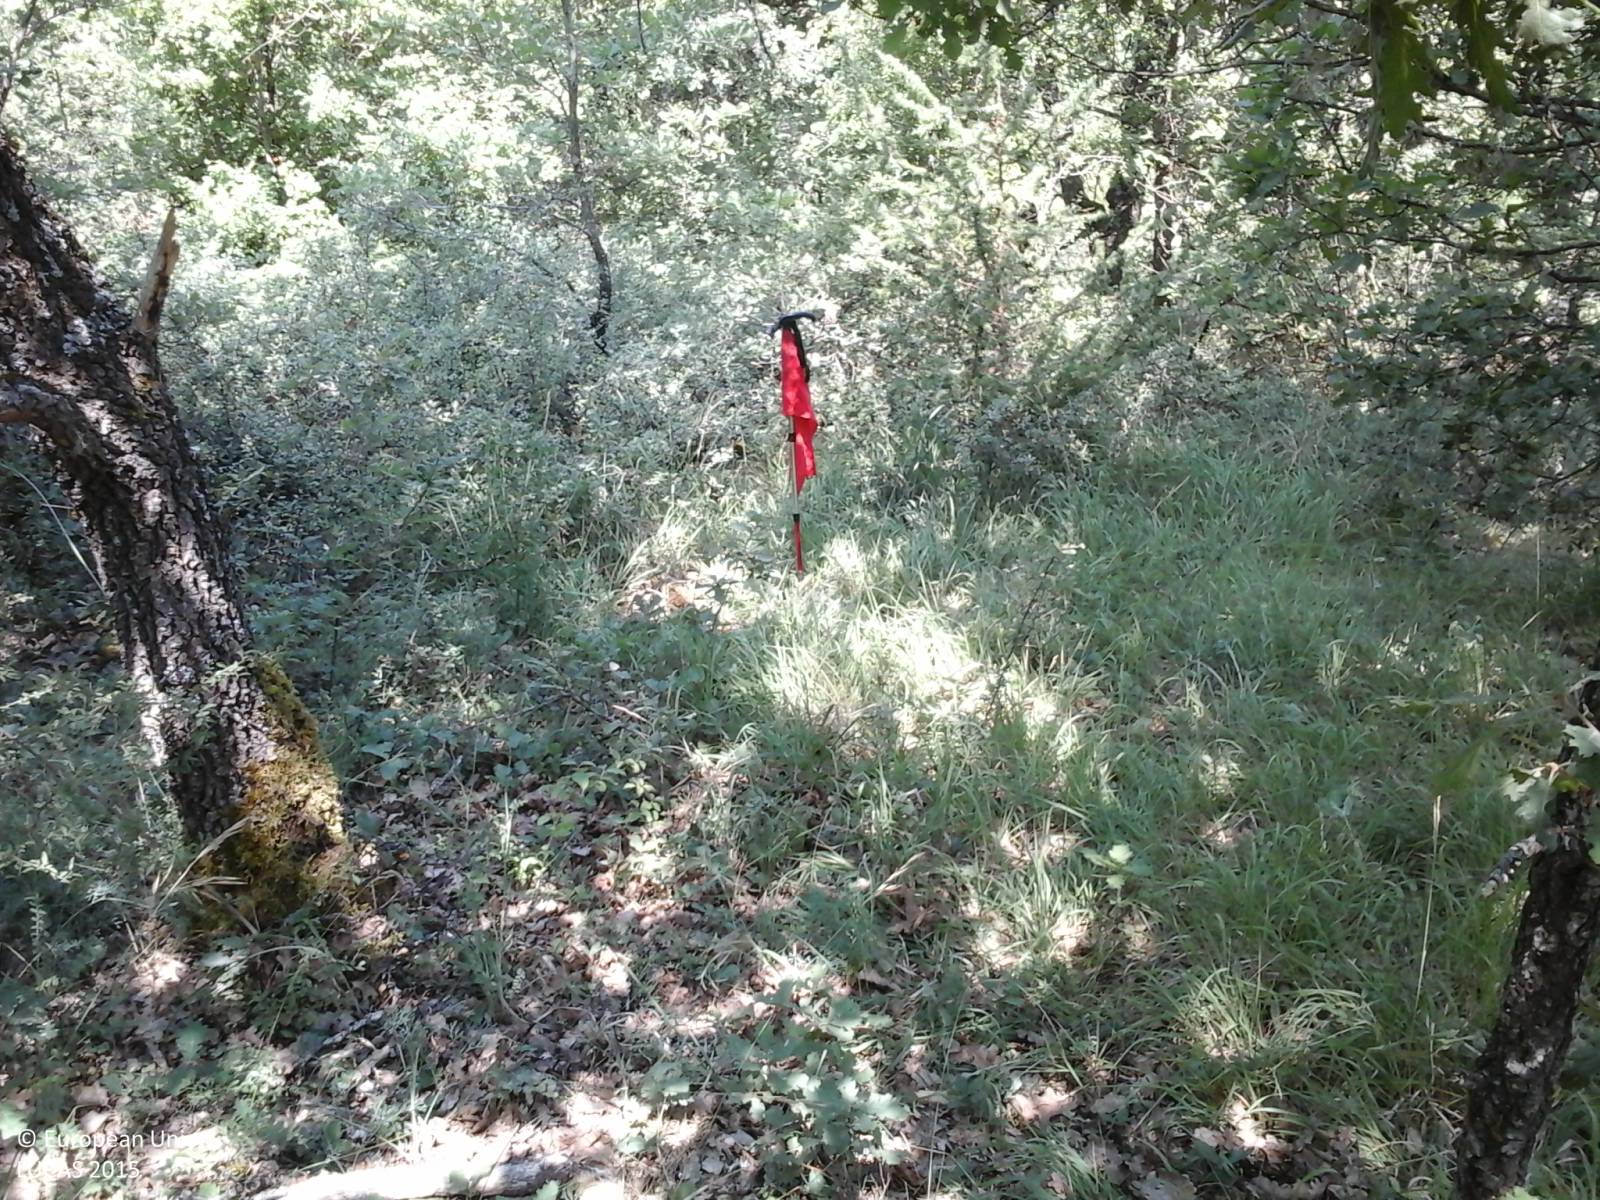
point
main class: Woodland
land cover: Broadleaved woodland
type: thermophilous deciduous forest
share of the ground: > 75 %
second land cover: Grassland without tree/shrub cover
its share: > 75 %
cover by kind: broadleaved forest trees 80 %, shrubs 10 %, herbaceous plants 10 %
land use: Forestry
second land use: Agriculture (excluding fallow land and kitchen gardens)
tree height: > 5 m
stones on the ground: 25 - 50 %
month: July
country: IT
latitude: 42.3463
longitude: 13.3274
